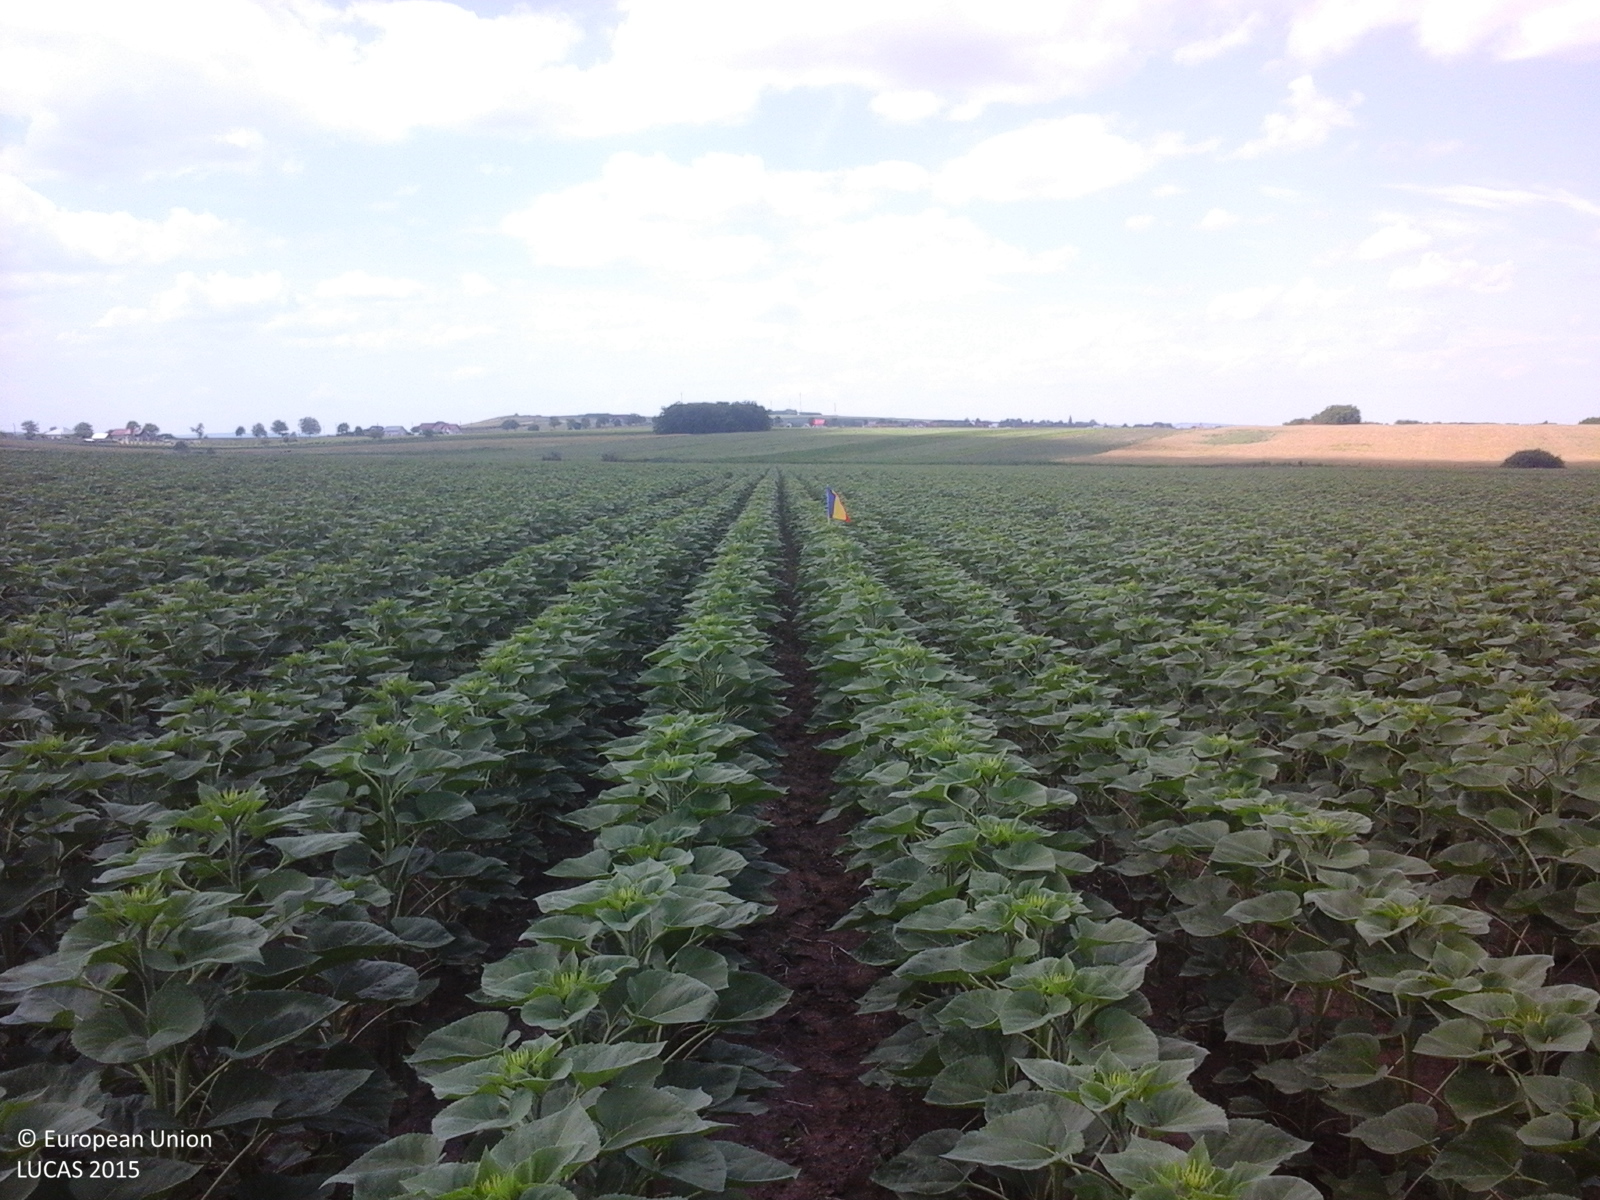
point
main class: Cropland
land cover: Sunflower
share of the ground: > 75 %
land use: Agriculture (excluding fallow land and kitchen gardens)
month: June
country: RO
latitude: 47.8988
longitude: 26.4220
